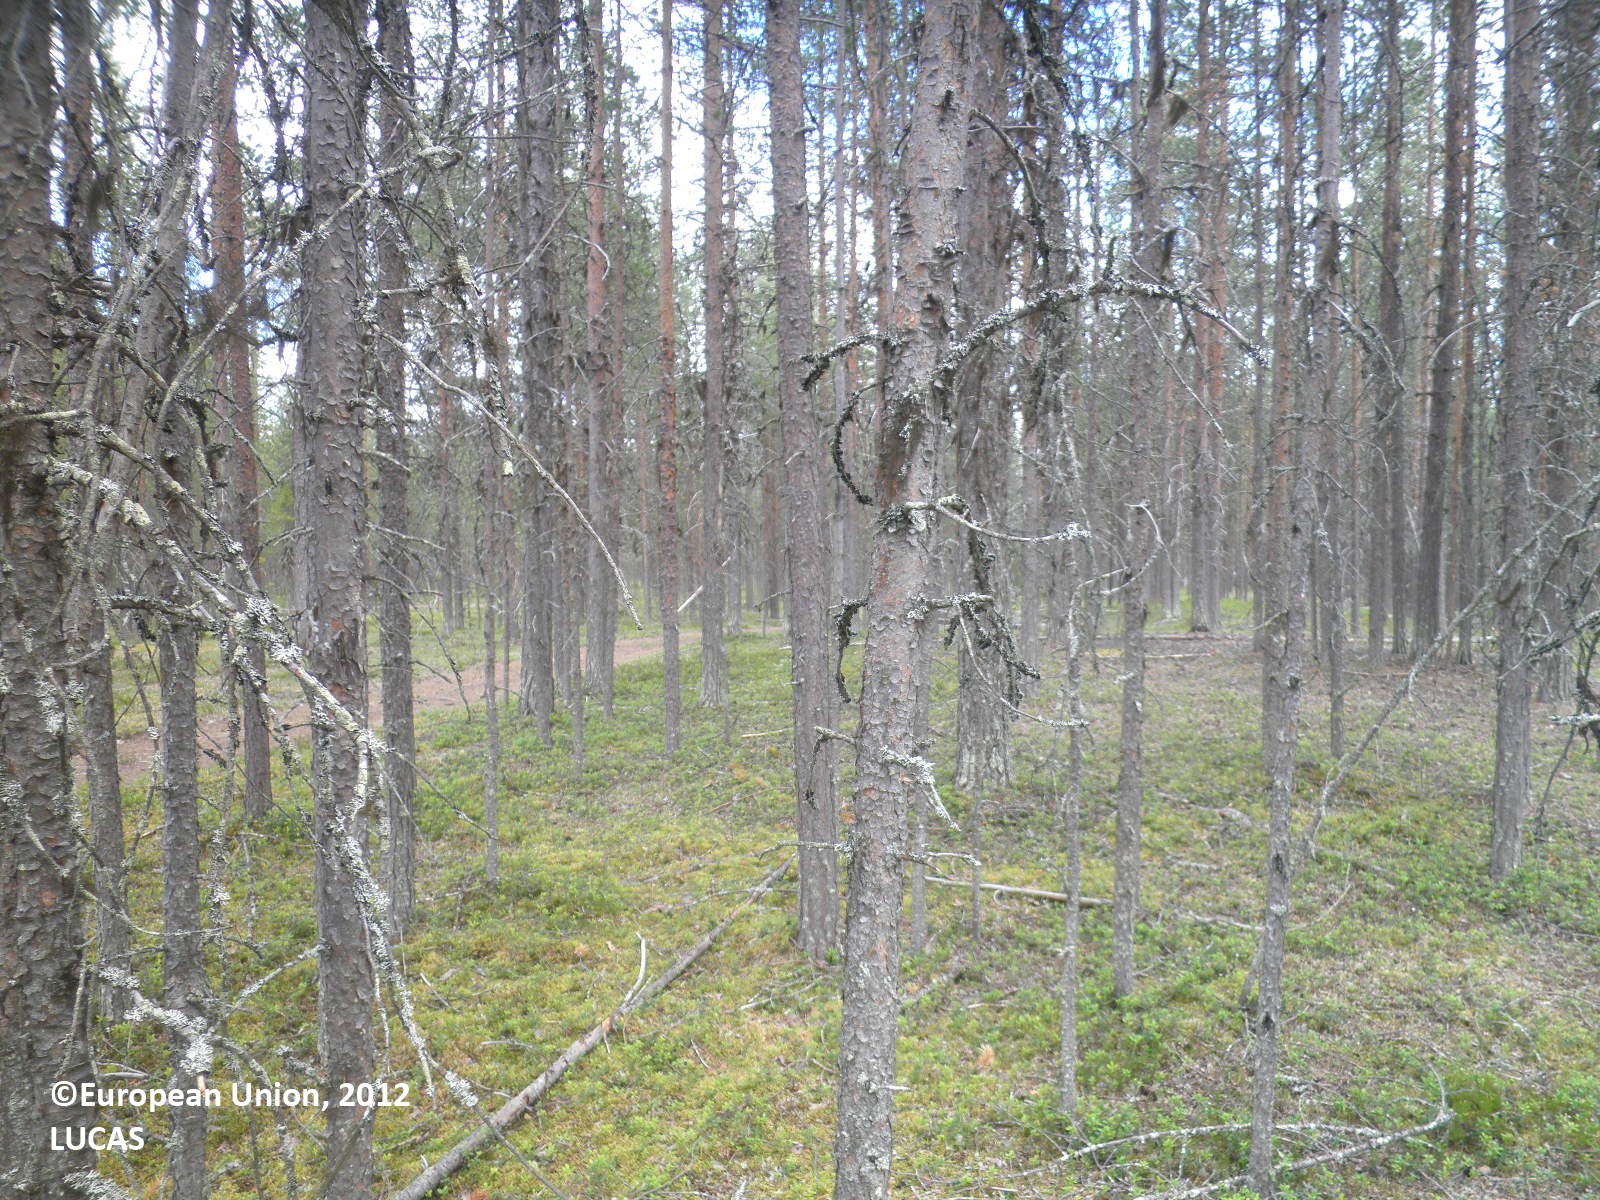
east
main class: Woodland
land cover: Pine dominated coniferous woodland
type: boreal forest
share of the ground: 50 - 75 %
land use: Forestry
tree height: > 5 m
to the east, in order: Pine dominated coniferous woodland; Tracks; Pine dominated coniferous woodland; Pine dominated mixed woodland
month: July
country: FI
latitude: 67.5407
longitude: 25.8898
